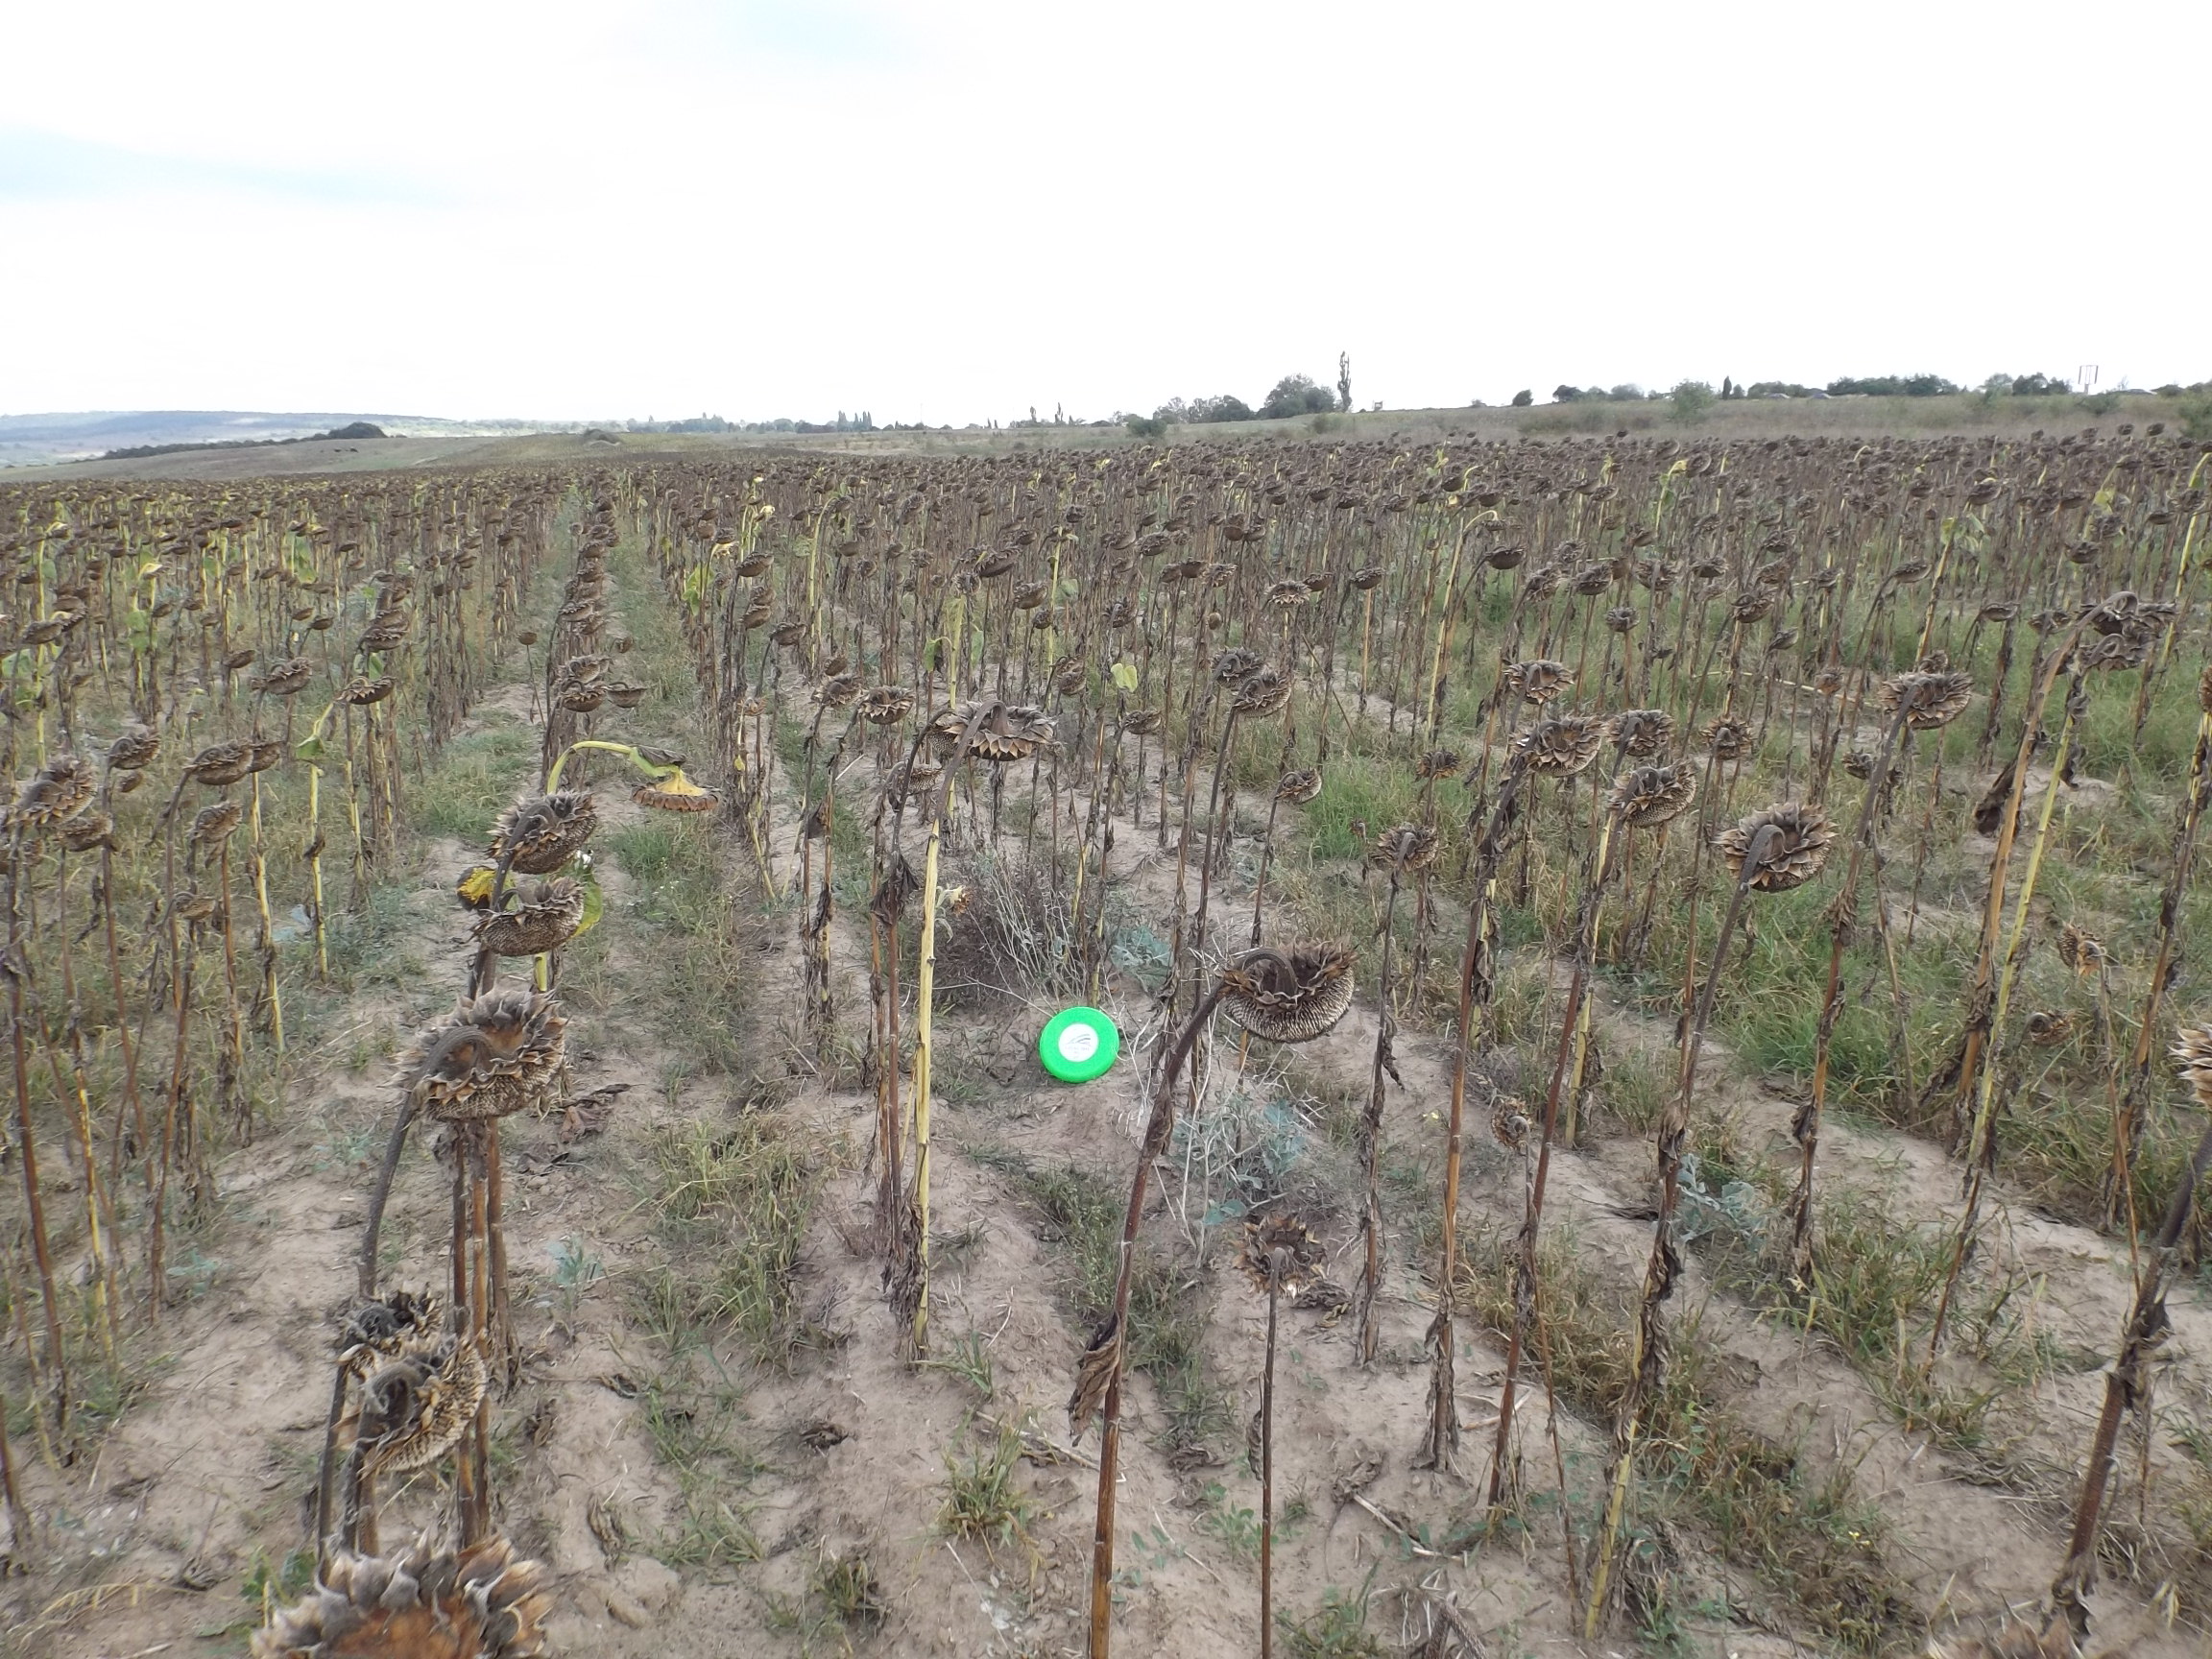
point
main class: Cropland
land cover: Sunflower
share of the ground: 25 - 50 %
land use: Agriculture (excluding fallow land and kitchen gardens)
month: September
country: BG
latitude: 43.0632
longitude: 27.8545
